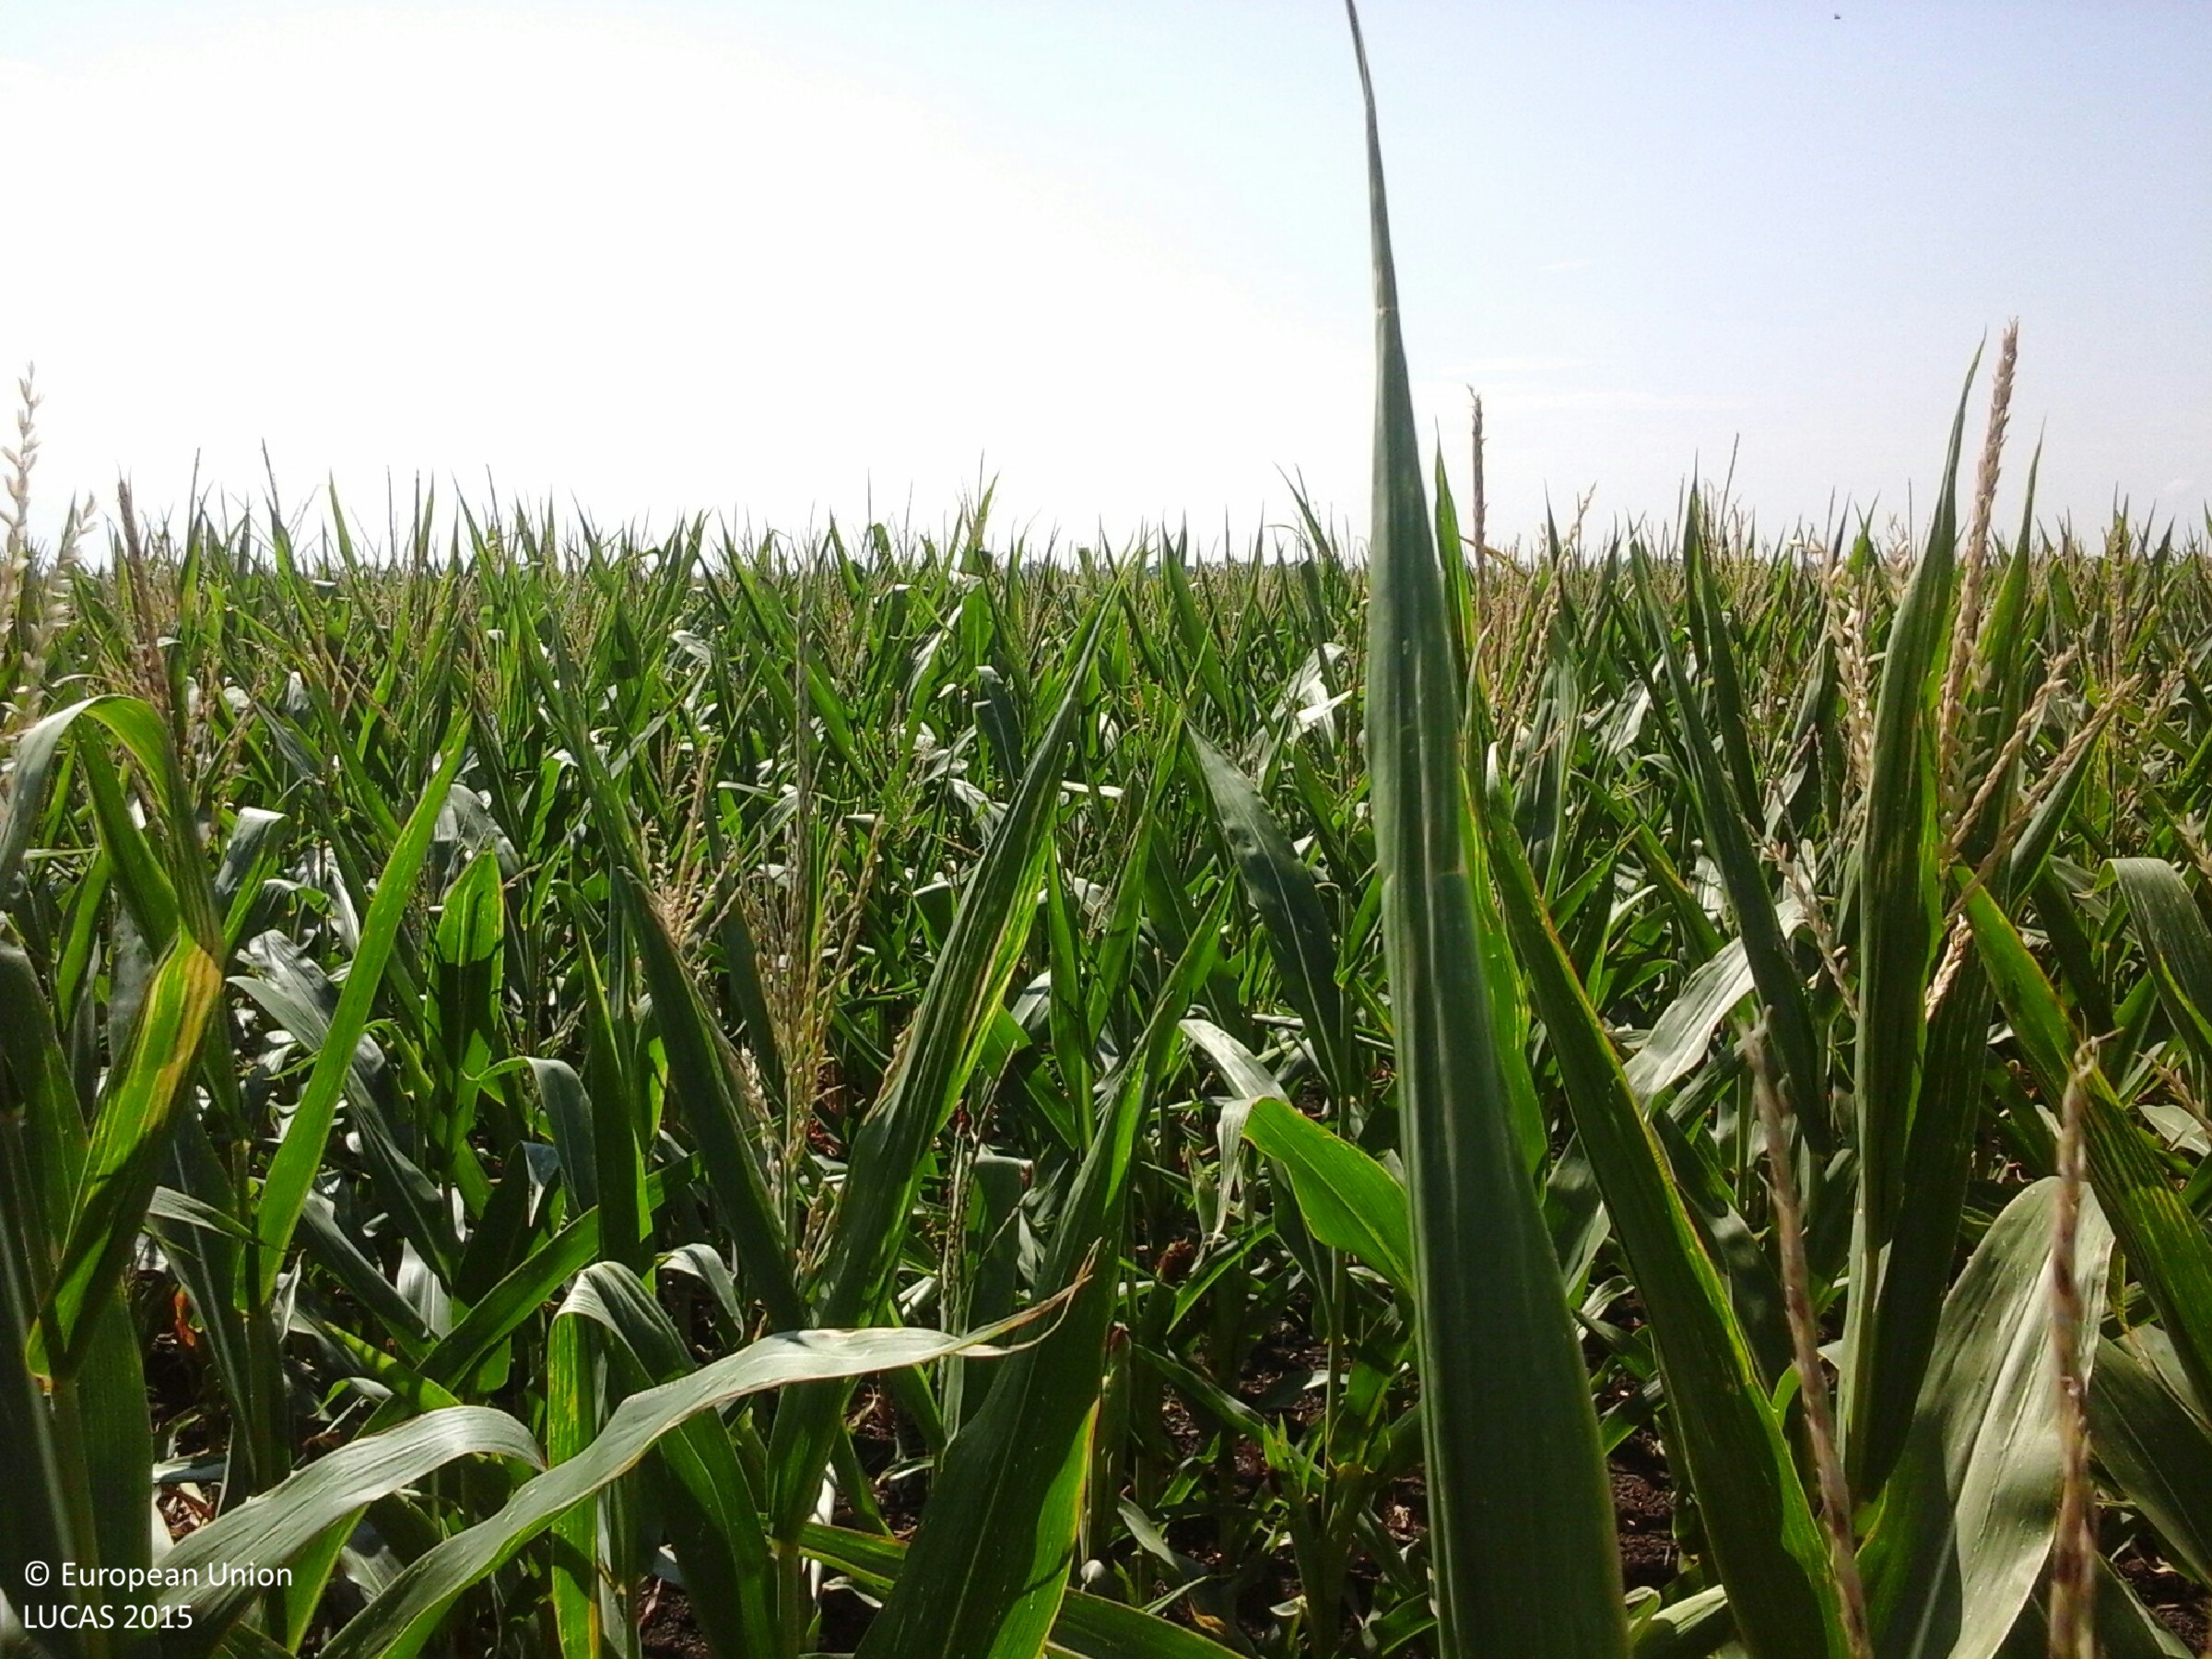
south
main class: Cropland
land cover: Maize
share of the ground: > 75 %
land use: Agriculture (excluding fallow land and kitchen gardens)
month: August
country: HU
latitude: 47.3897
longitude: 20.9113
